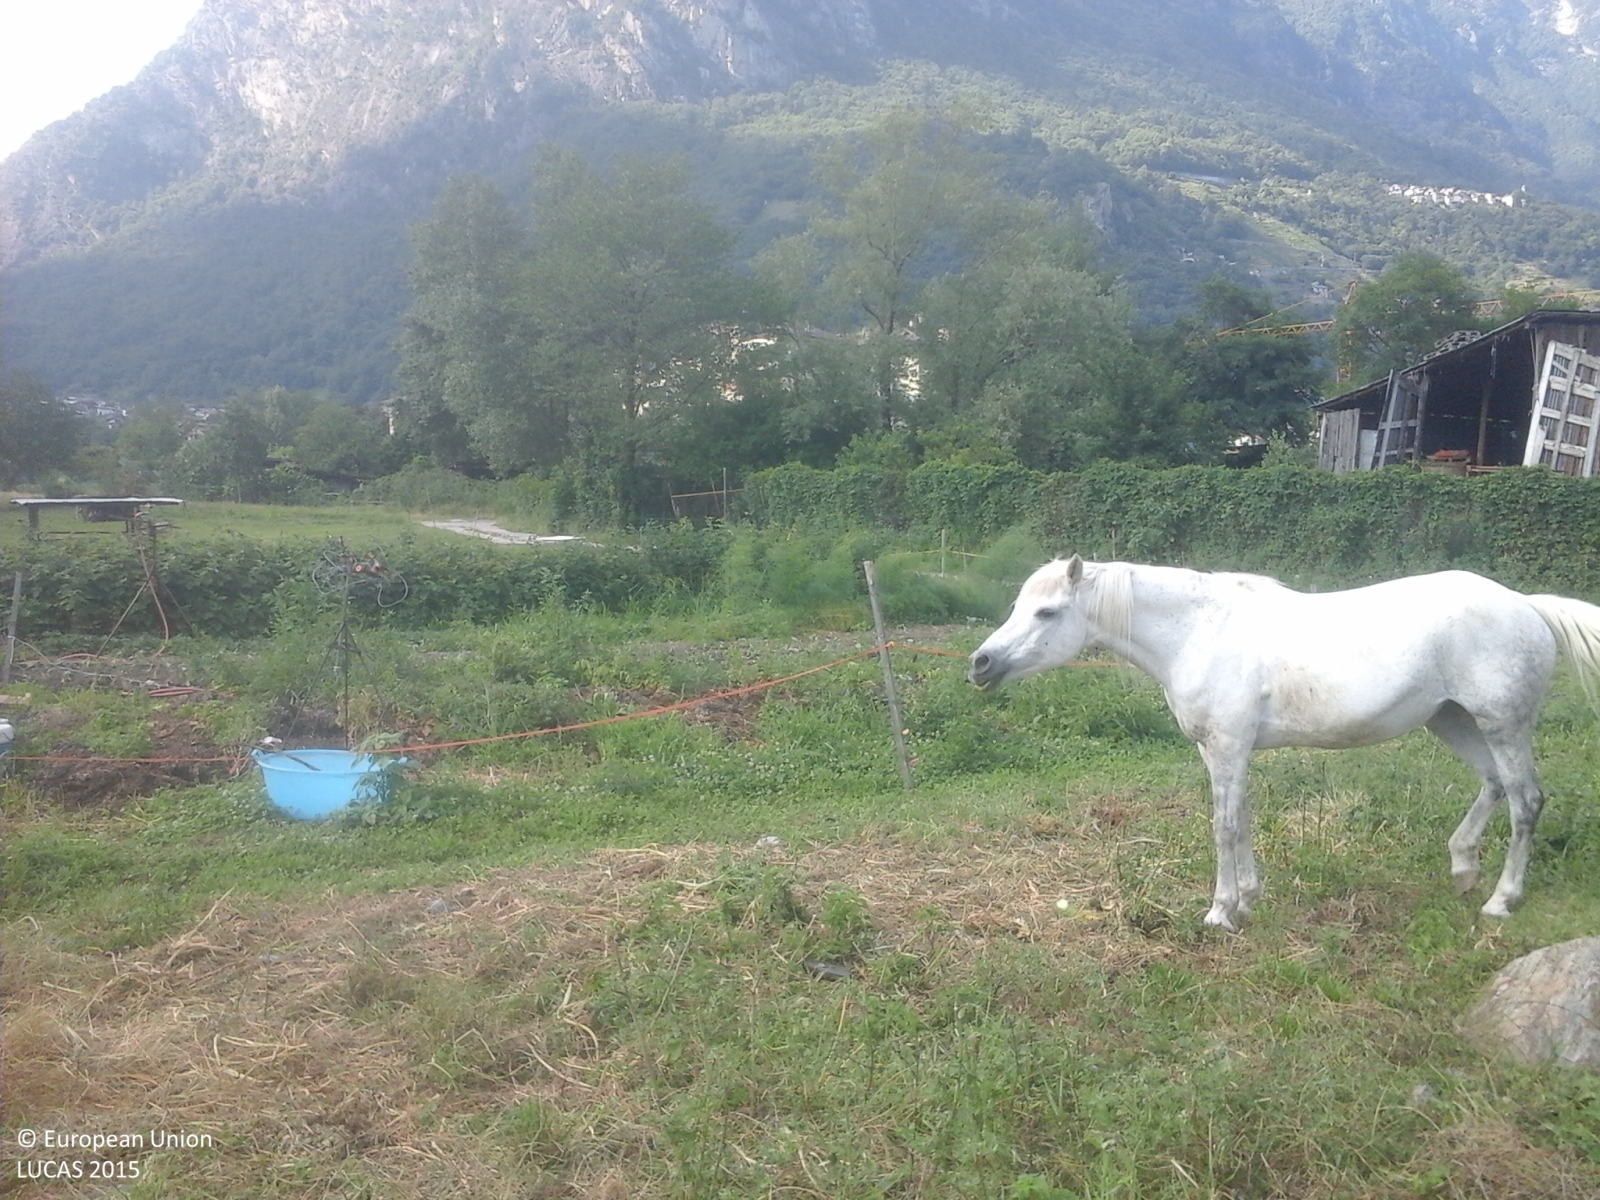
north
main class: Grassland
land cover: Grassland without tree/shrub cover
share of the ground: > 75 %
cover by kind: herbaceous plants 100 %
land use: Agriculture (excluding fallow land and kitchen gardens)
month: July
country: IT
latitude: 46.3134
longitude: 9.3905
